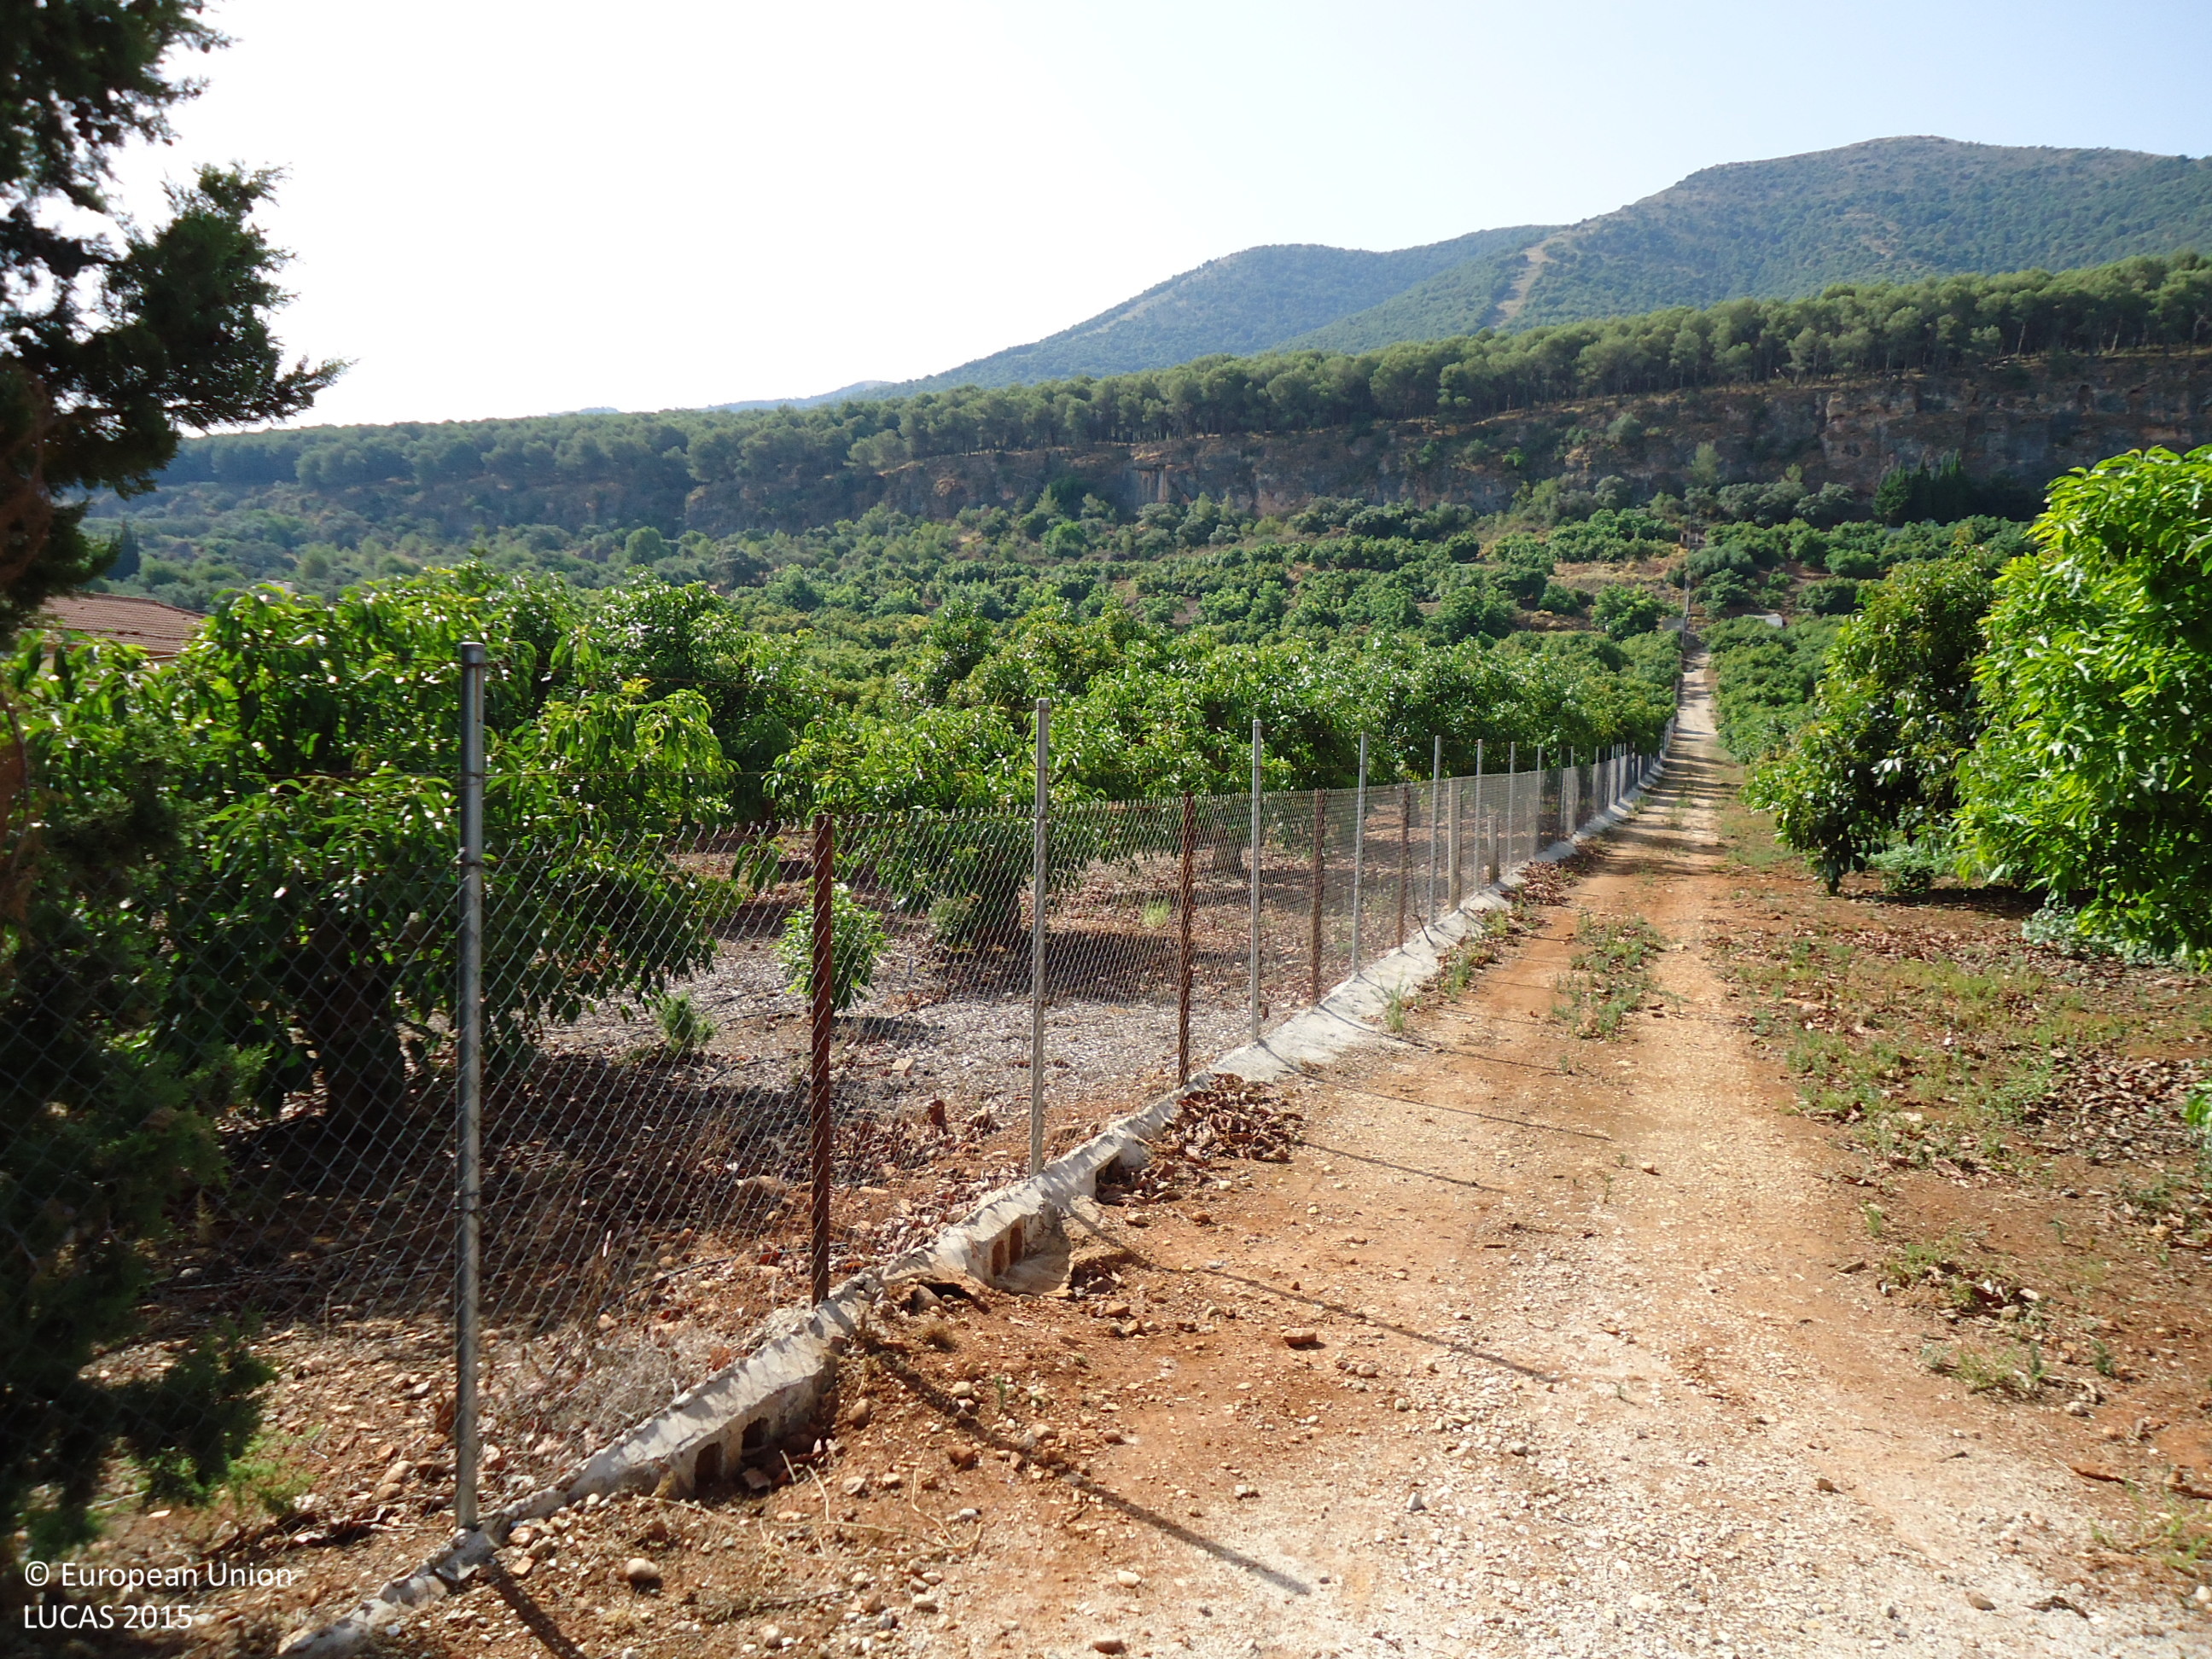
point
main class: Cropland
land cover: Other fruit trees and berries
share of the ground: > 75 %
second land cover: Other bare soil
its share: > 75 %
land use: Agriculture (excluding fallow land and kitchen gardens)
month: June
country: ES
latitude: 36.6389
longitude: -4.6763
